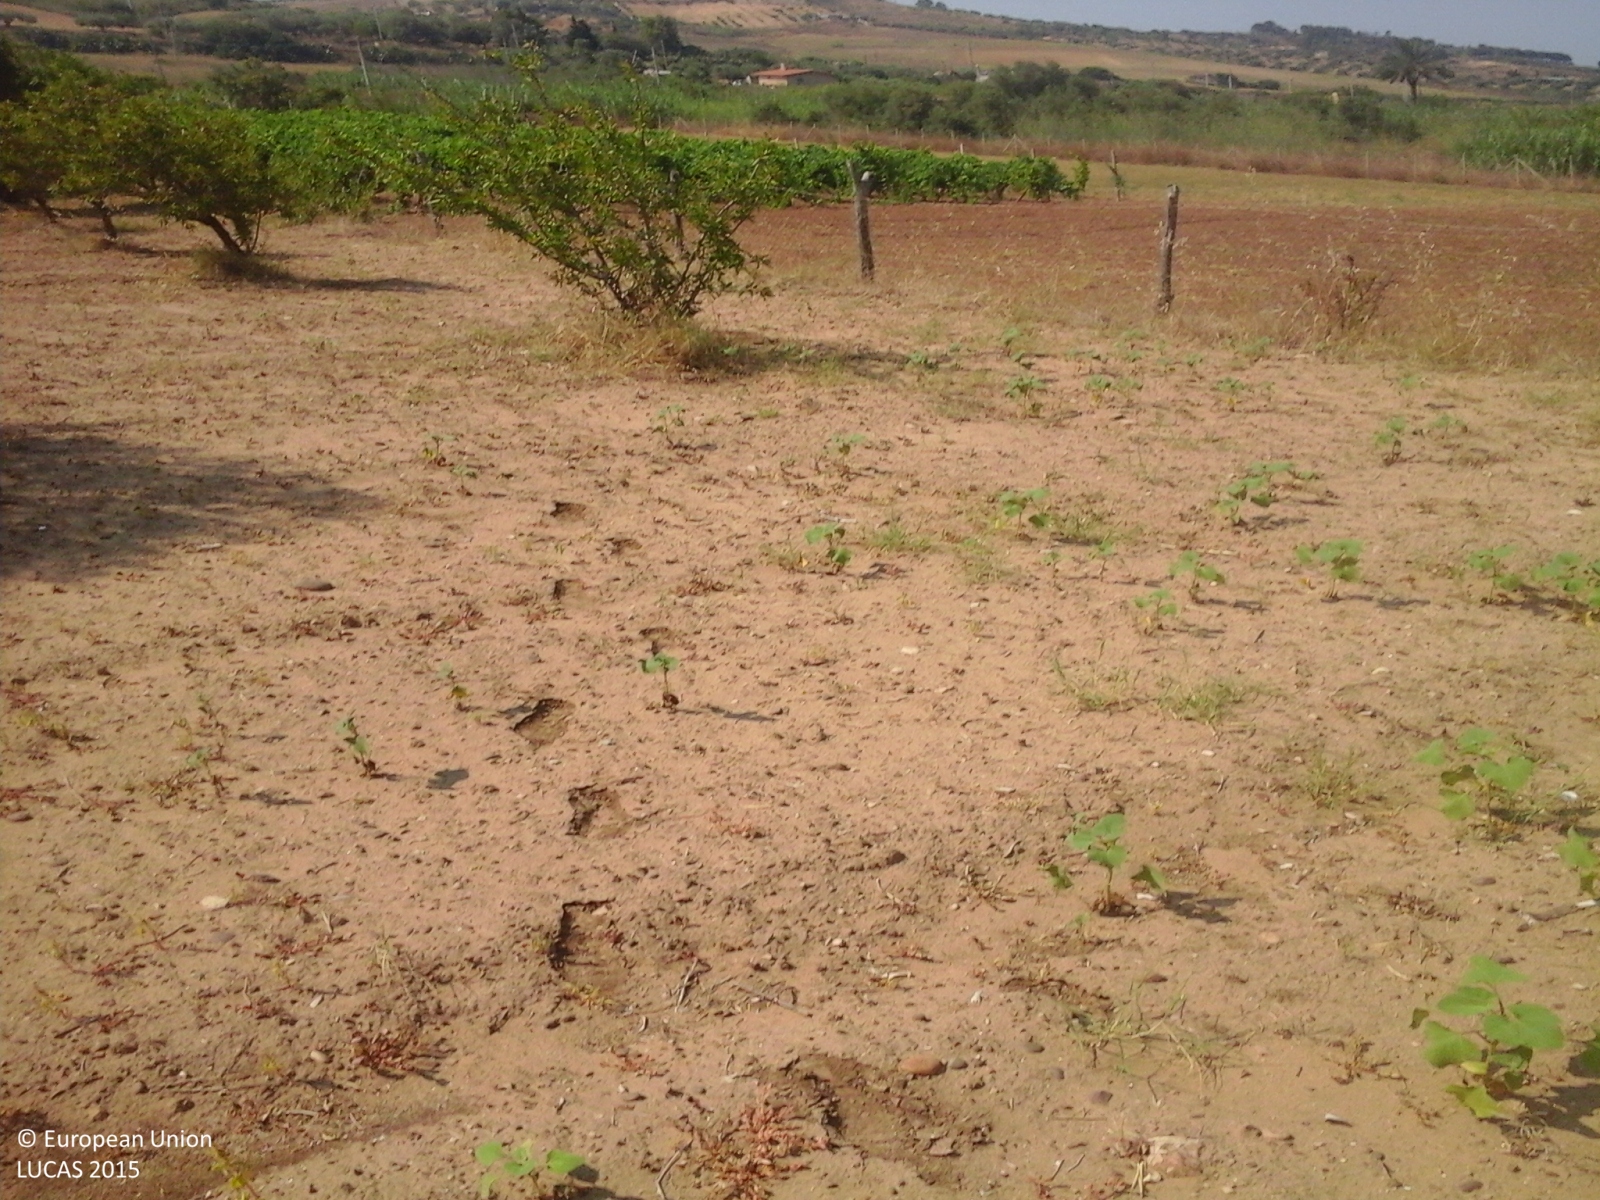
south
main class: Cropland
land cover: Durum wheat
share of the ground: > 75 %
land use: Agriculture (excluding fallow land and kitchen gardens)
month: July
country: IT
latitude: 37.0666
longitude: 14.3408
